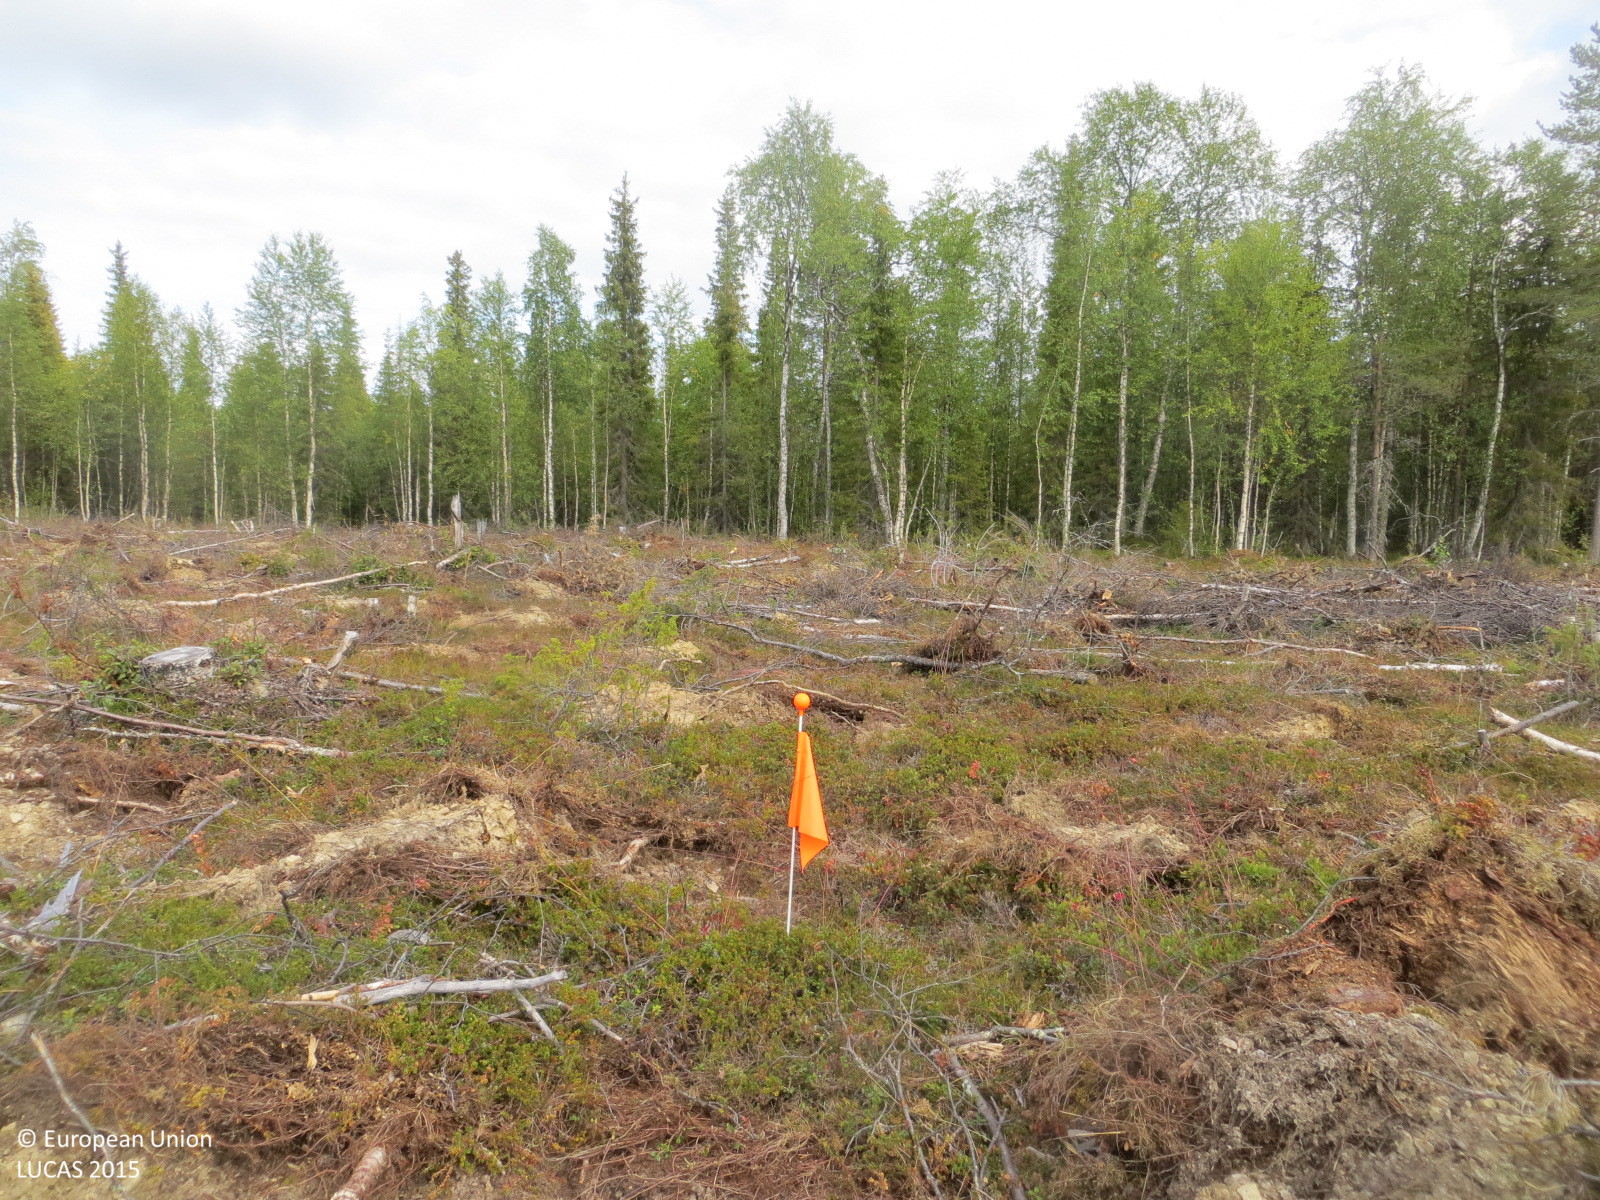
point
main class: Shrubland
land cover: Shrubland with sparse tree cover
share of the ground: > 75 %
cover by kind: shrubs 70 %, unconsolidated bare surface 10 %, coniferous forest trees 5 %, consolidated bare surface 5 %
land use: Forestry
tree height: > 5 m
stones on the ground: 25 - 50 %
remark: Clear cut
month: August
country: FI
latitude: 67.9312
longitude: 25.4728
